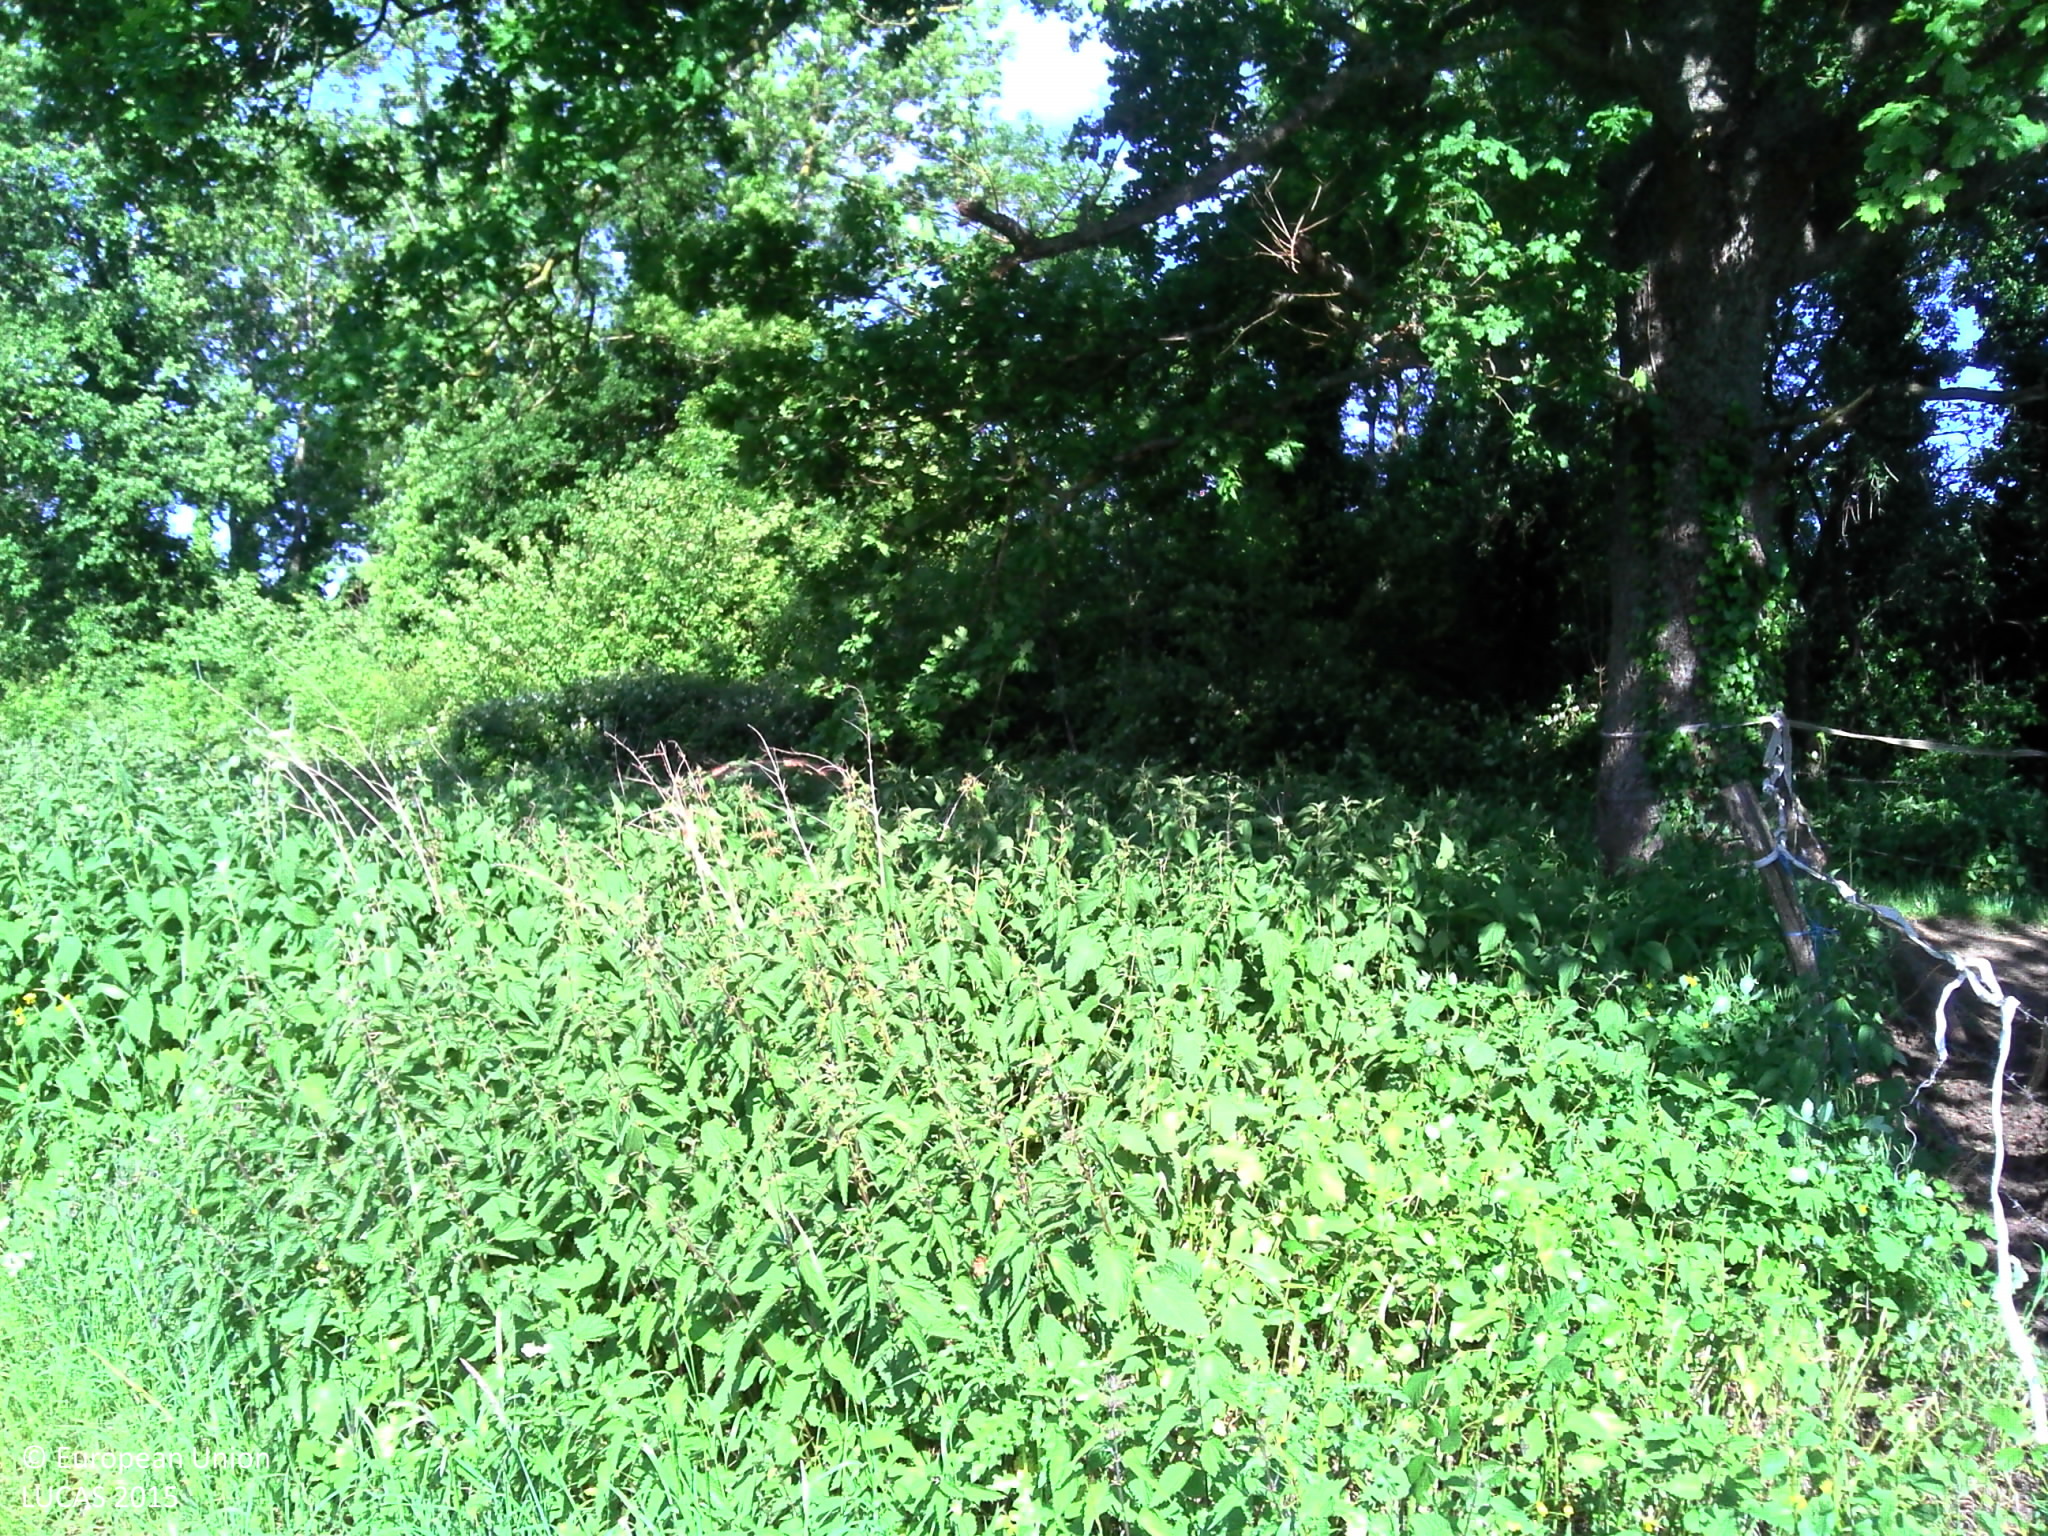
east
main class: Grassland
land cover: Grassland without tree/shrub cover
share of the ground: > 75 %
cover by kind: herbaceous plants 95 %, shrubs 5 %
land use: Agriculture (excluding fallow land and kitchen gardens)
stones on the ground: < 10 %
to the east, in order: Grassland without tree/shrub cover; Fences; Broadleaved woodland; Grassland without tree/shrub cover; Electric lines; Grassland without tree/shrub cover
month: May
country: FR
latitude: 46.3084
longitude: 2.8165
